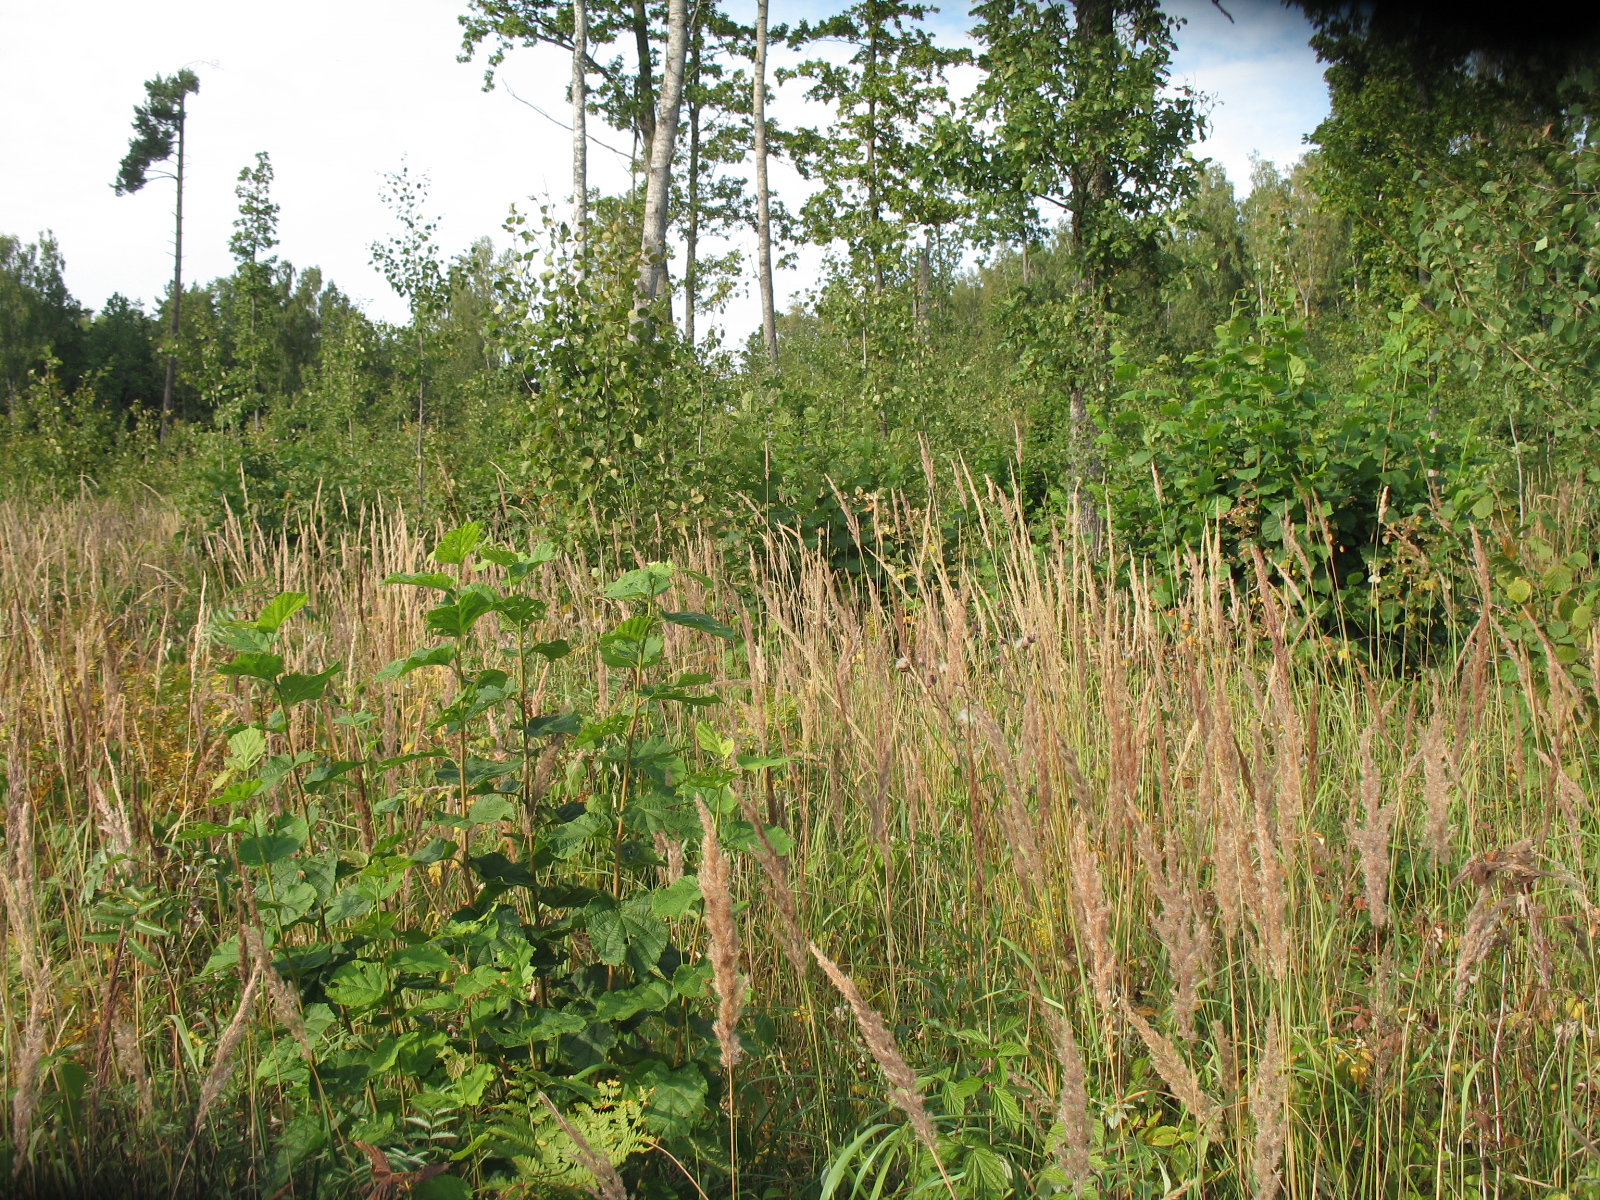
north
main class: Woodland
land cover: Broadleaved woodland
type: non-riverine alder, birch or aspen forest
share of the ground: 10 - 25 %
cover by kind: herbaceous plants 60 %, broadleaved forest trees 20 %, shrubs 20 %
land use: Forestry
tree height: < 5 m
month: August
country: LV
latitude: 56.3128
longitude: 25.5609
